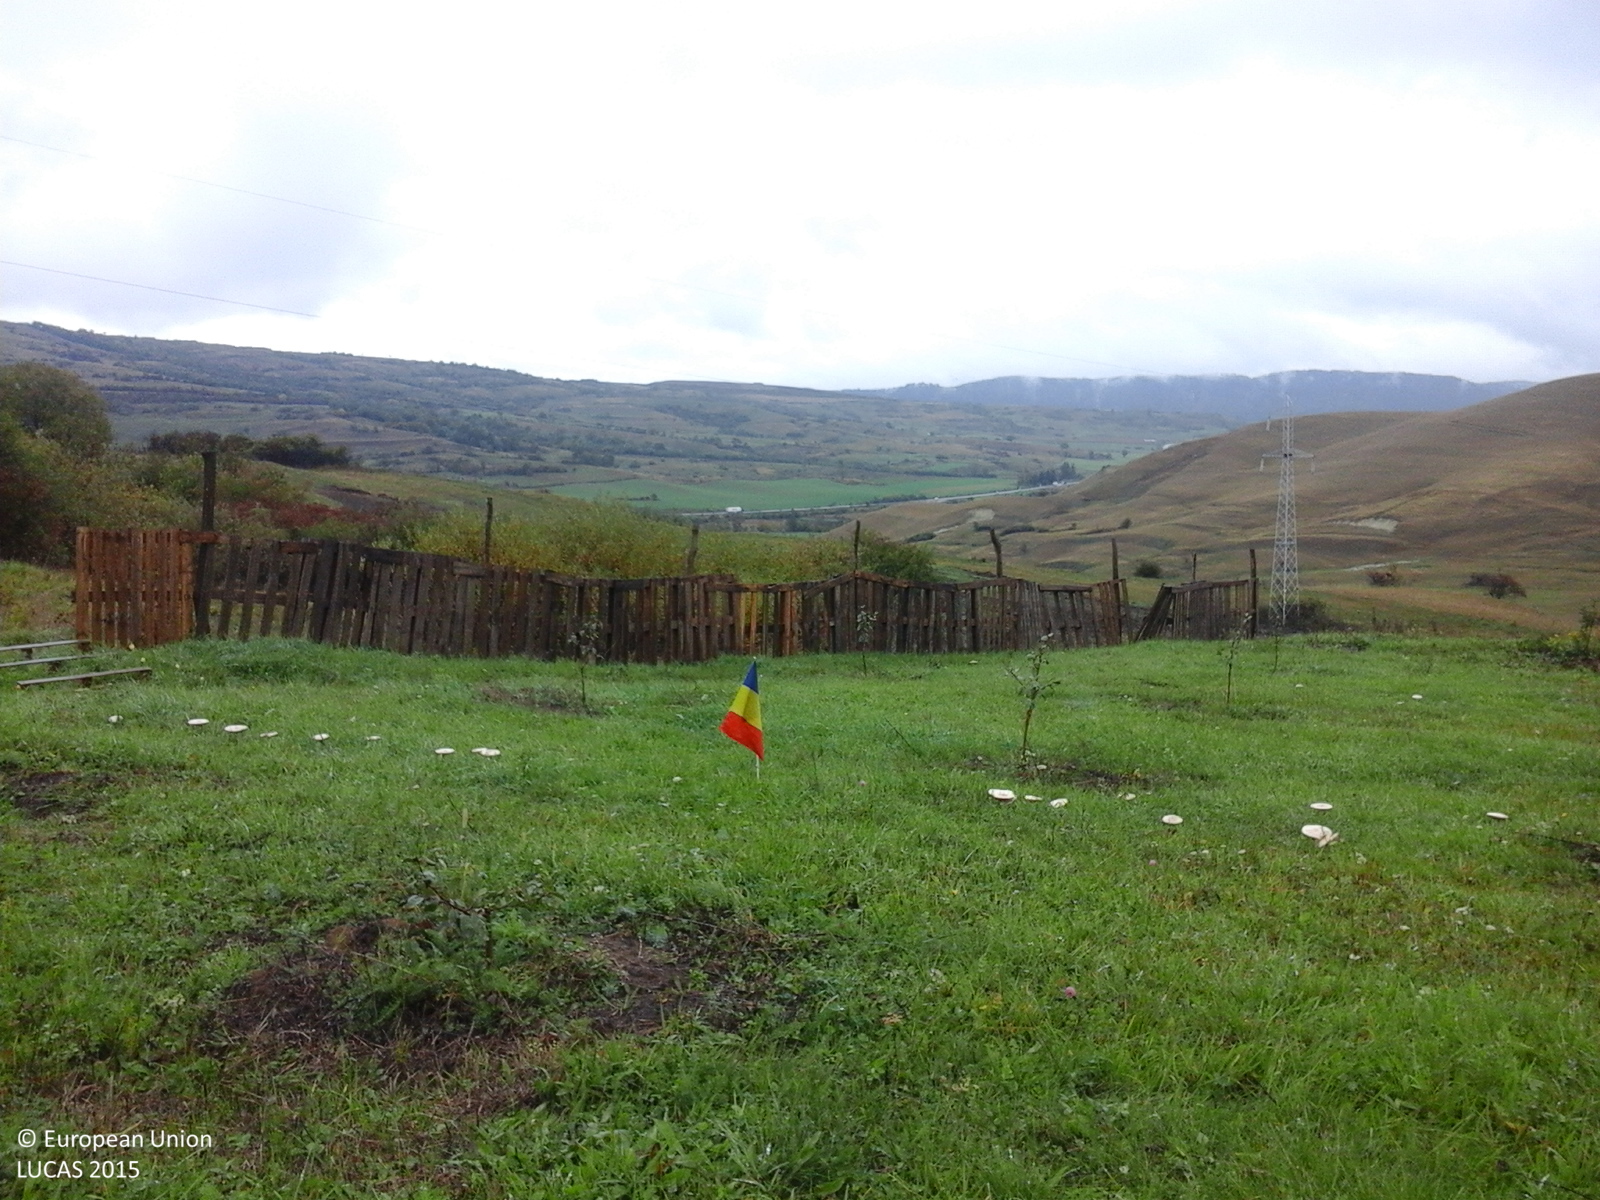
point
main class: Cropland
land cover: Apple fruit
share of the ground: 10 - 25 %
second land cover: Grassland without tree/shrub cover
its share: > 75 %
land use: Agriculture (excluding fallow land and kitchen gardens)
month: October
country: RO
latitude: 45.9881
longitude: 24.1609
